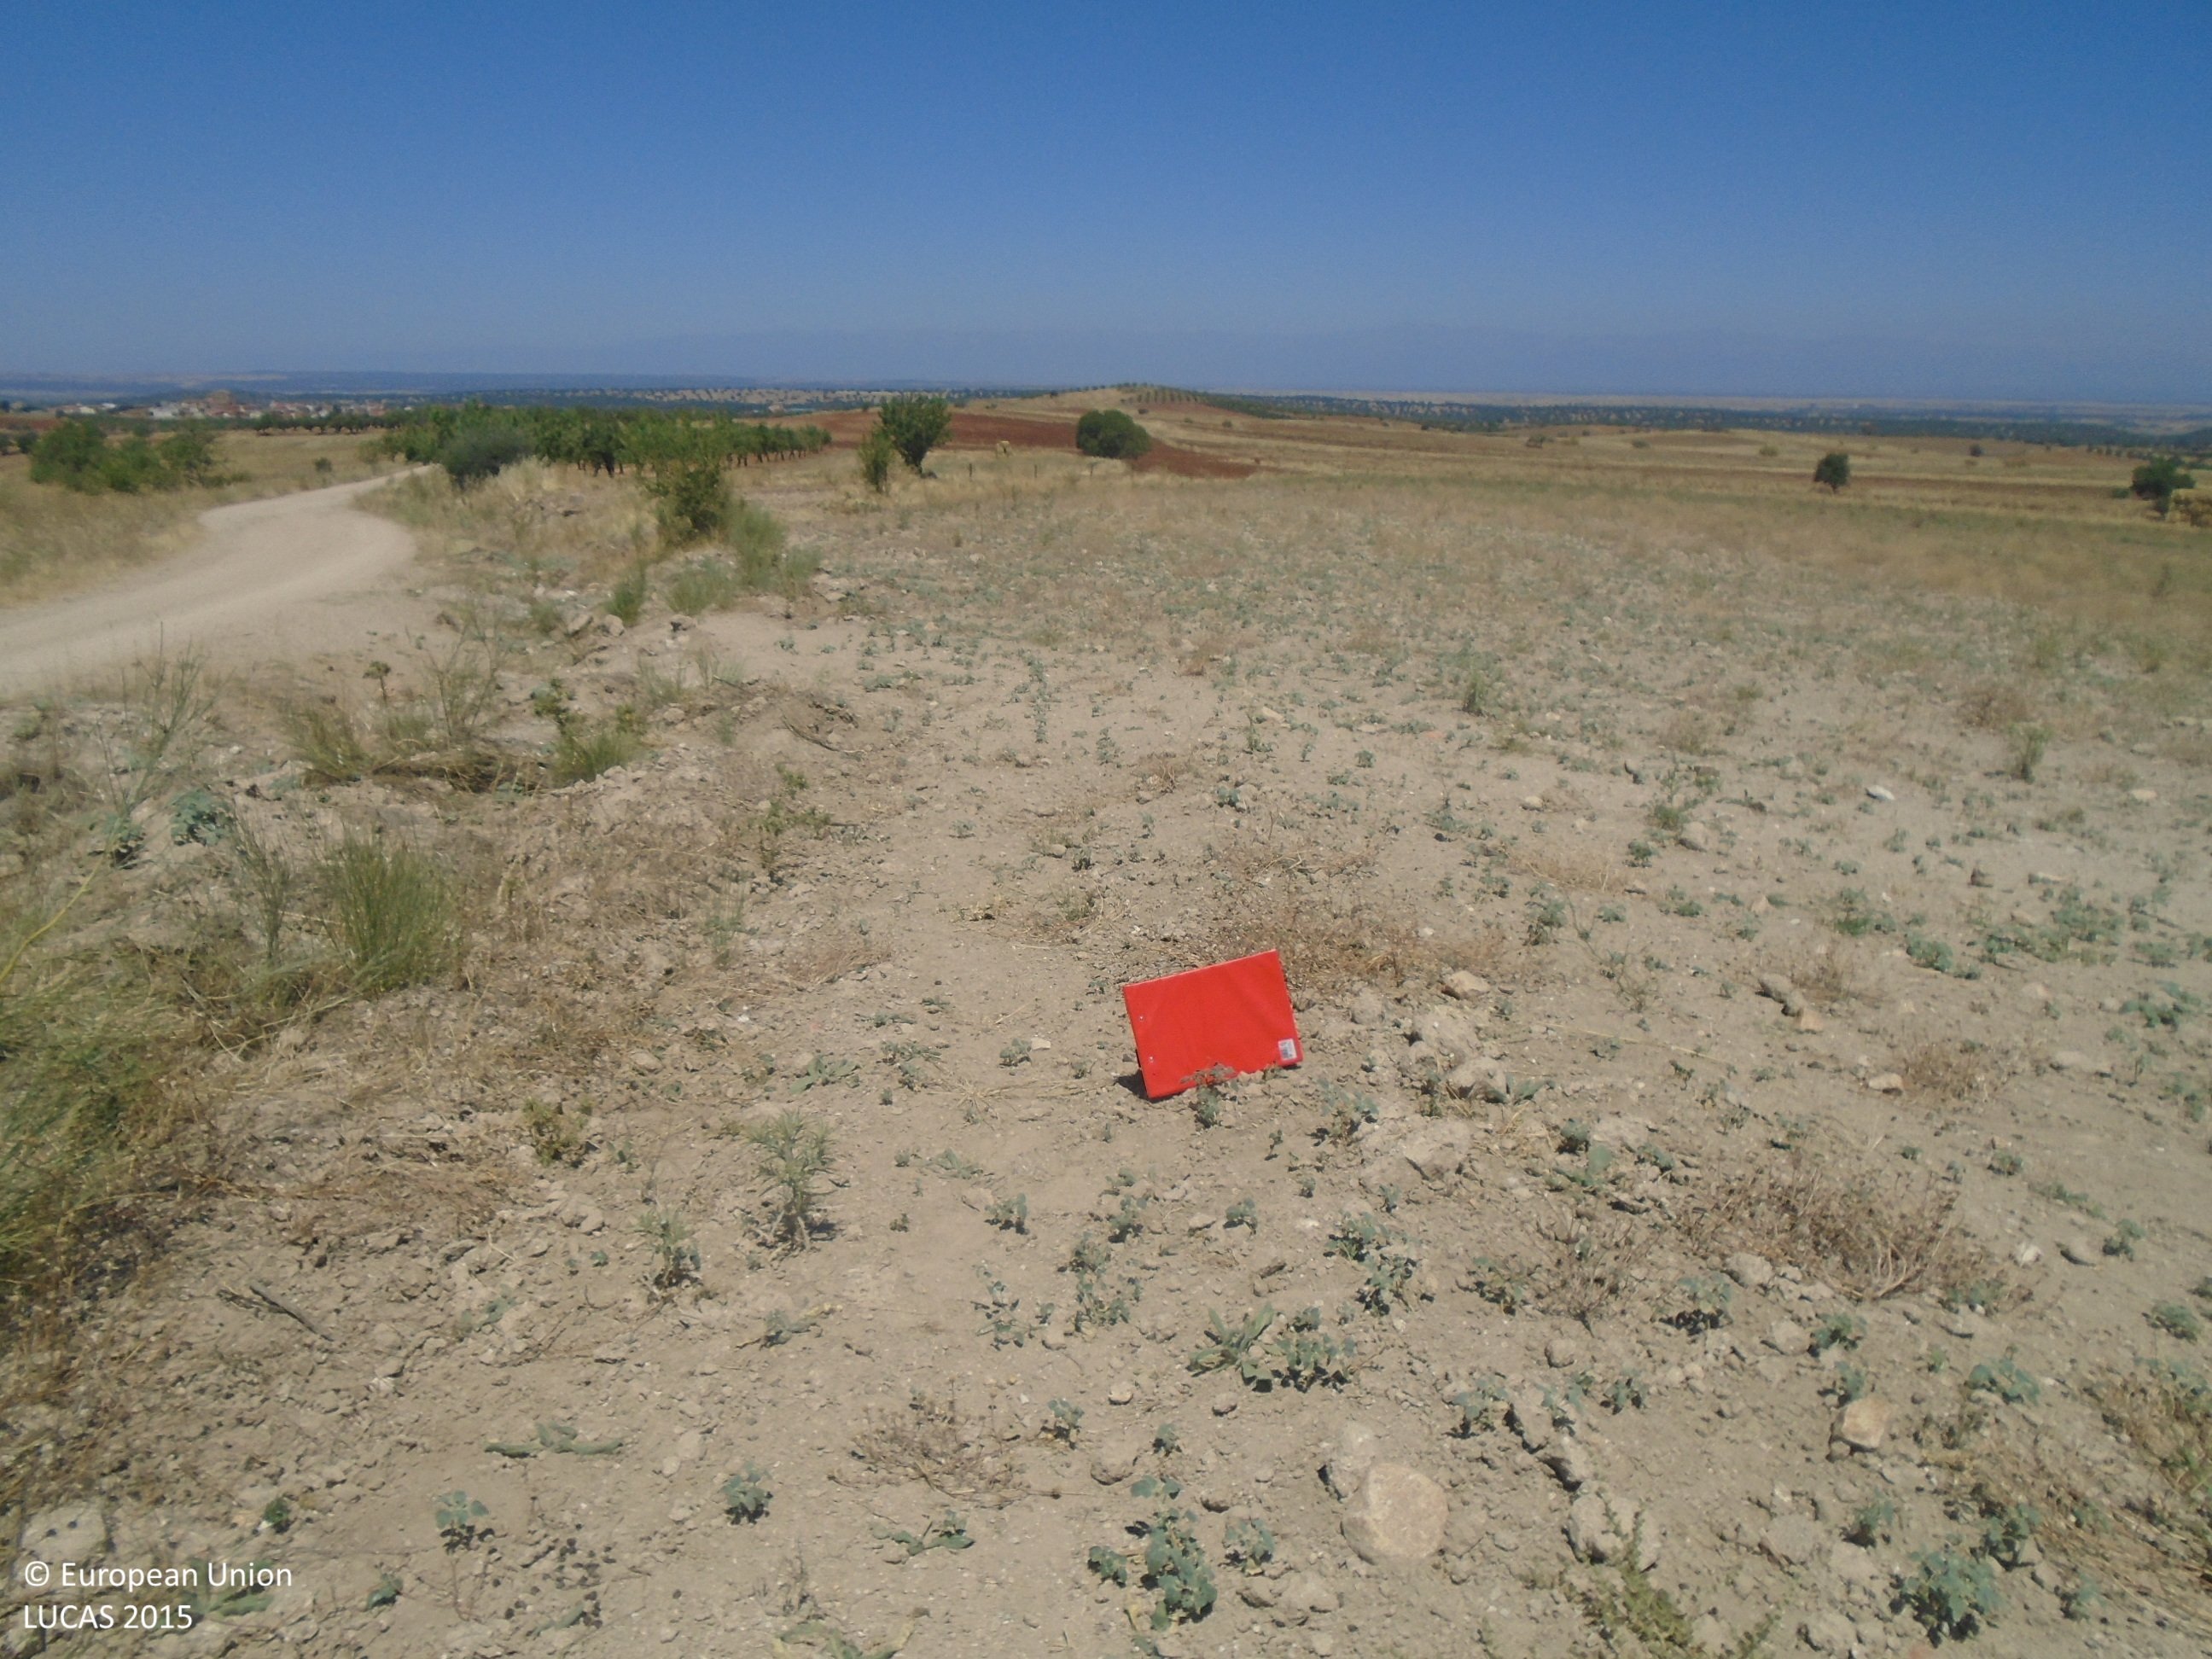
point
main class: Grassland
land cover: Spontaneously vegetated surfaces
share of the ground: > 75 %
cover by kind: herbaceous plants 90 %, unconsolidated bare surface 10 %
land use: Agriculture (excluding fallow land and kitchen gardens)
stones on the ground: < 10 %
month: July
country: ES
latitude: 39.7500
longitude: -4.9977
